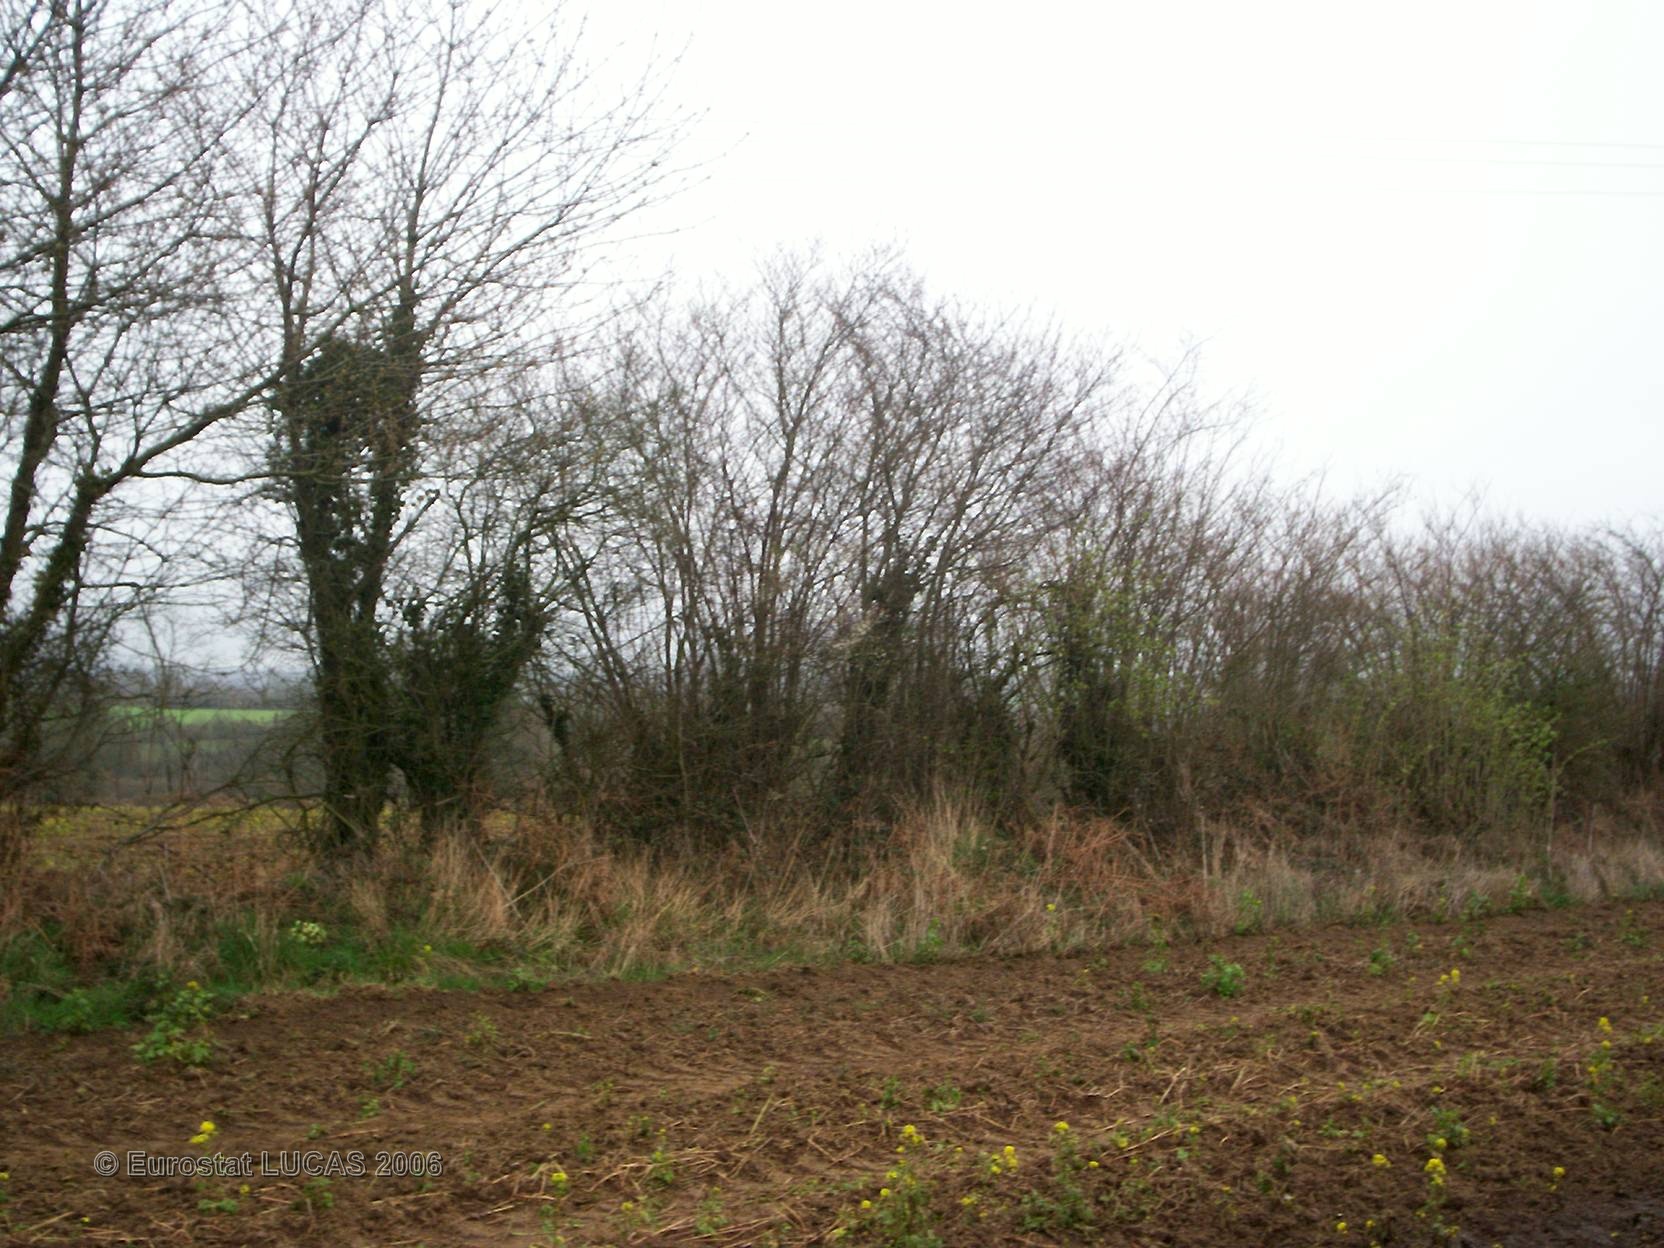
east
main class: Cropland
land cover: Maize
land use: Agriculture (excluding fallow land and kitchen gardens)
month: May
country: FR
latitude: 49.5159
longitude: -1.6120
